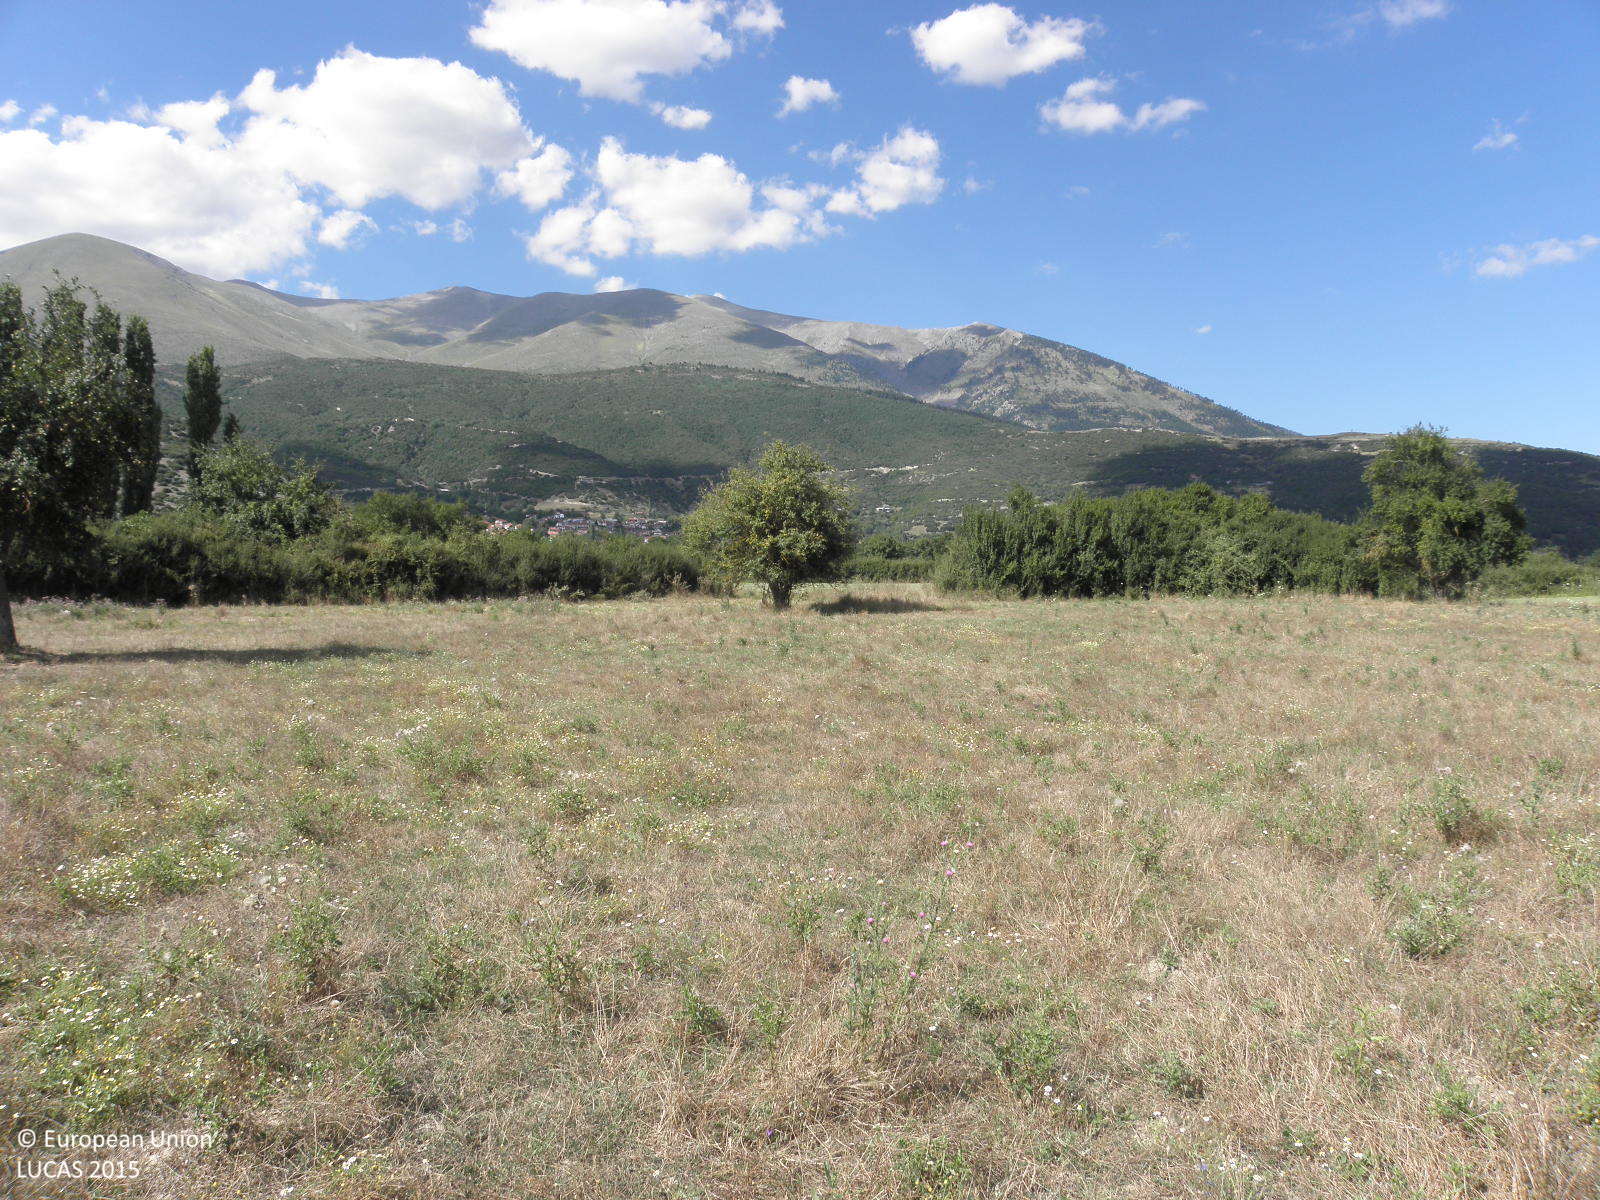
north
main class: Grassland
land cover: Spontaneously vegetated surfaces
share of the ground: > 75 %
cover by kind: herbaceous plants 100 %
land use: Fallow land
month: August
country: GR
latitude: 39.9719
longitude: 22.3928
